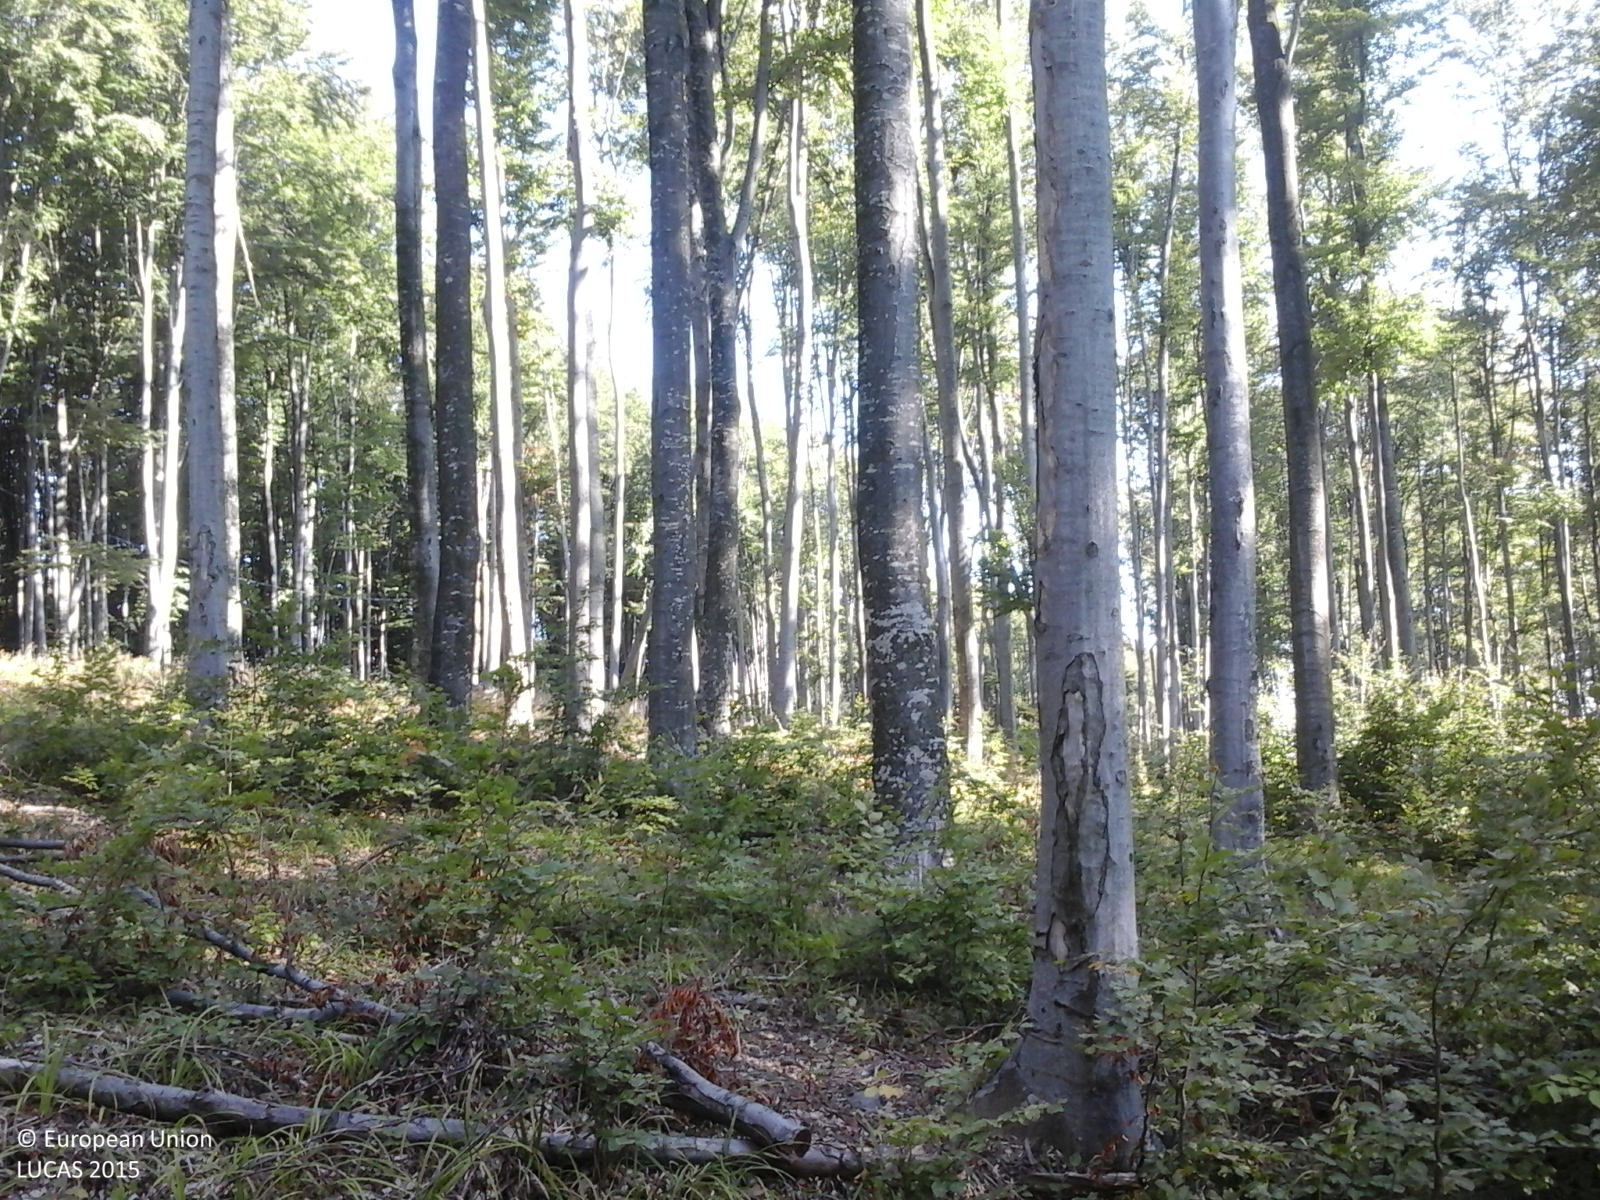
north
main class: Woodland
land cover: Broadleaved woodland
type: beech forest
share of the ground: > 75 %
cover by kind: broadleaved forest trees 100 %
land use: Forestry
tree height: > 5 m
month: September
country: RO
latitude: 47.1310
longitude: 22.4599
